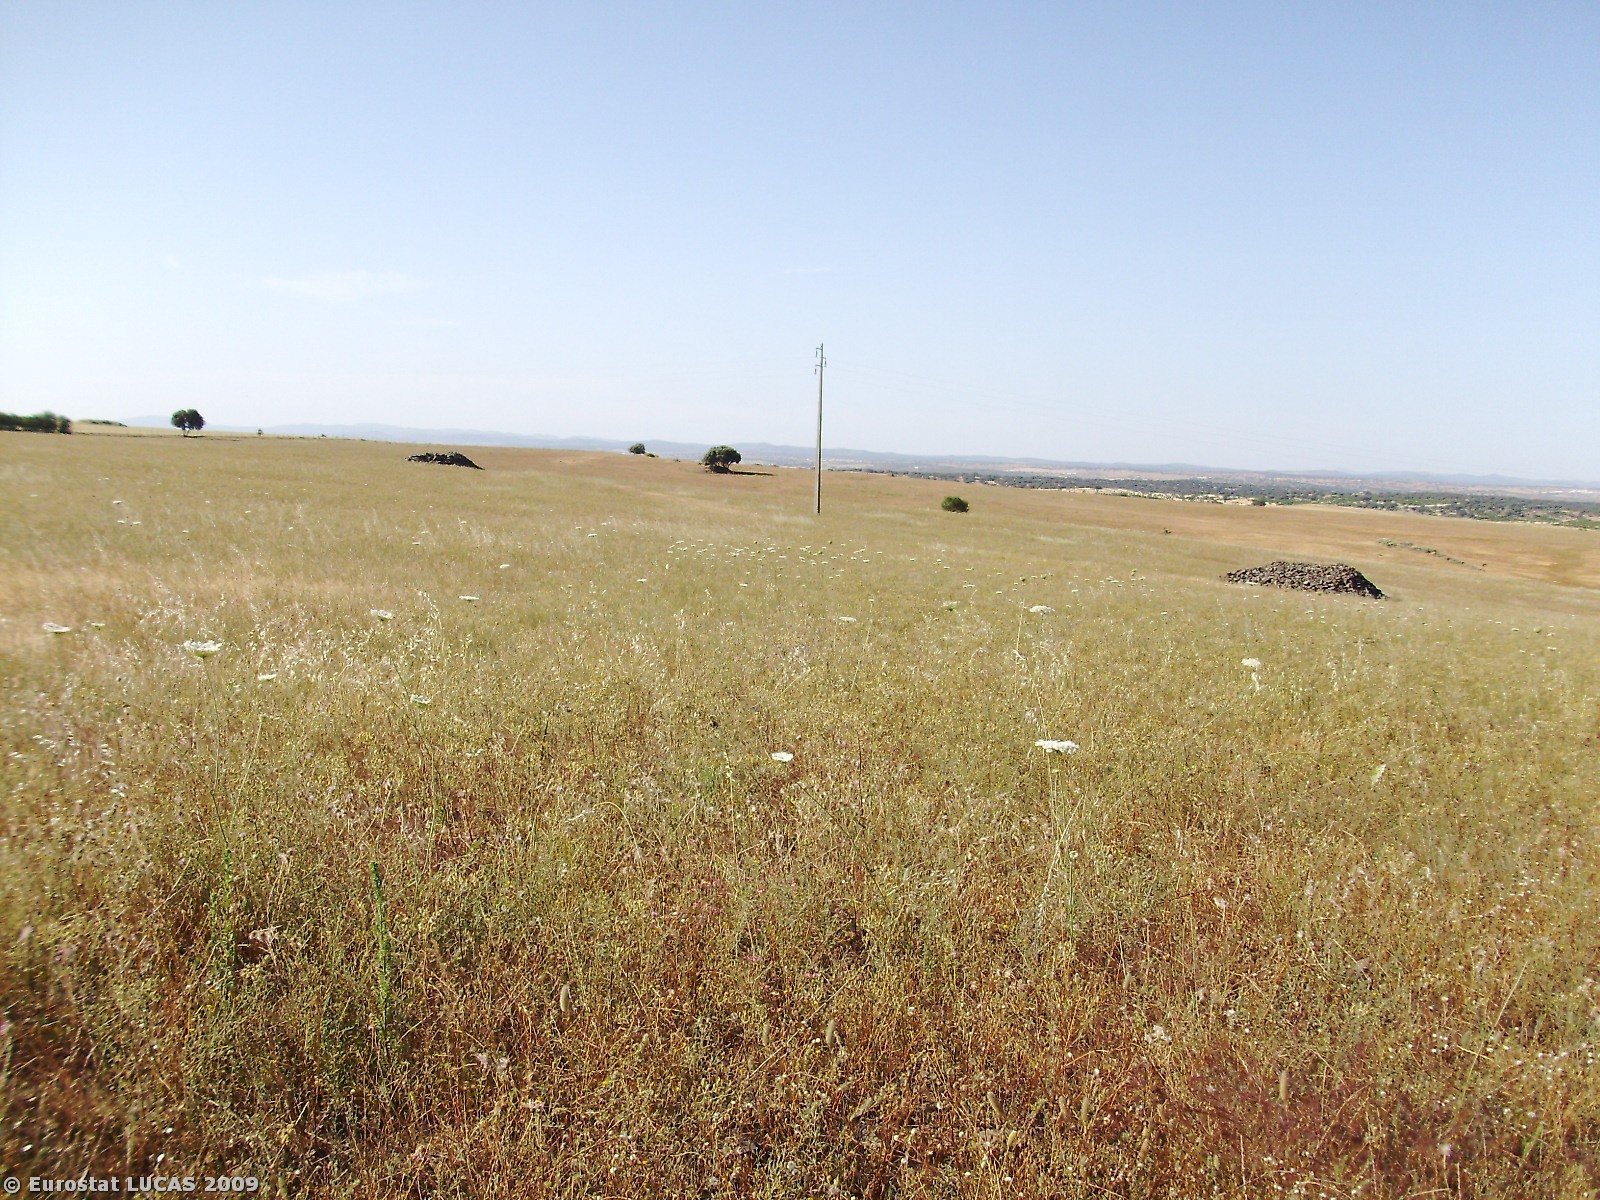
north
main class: Grassland
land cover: Spontaneously vegetated surfaces
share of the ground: > 75 %
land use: Fallow land
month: May
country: PT
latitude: 38.9587
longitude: -7.1899
